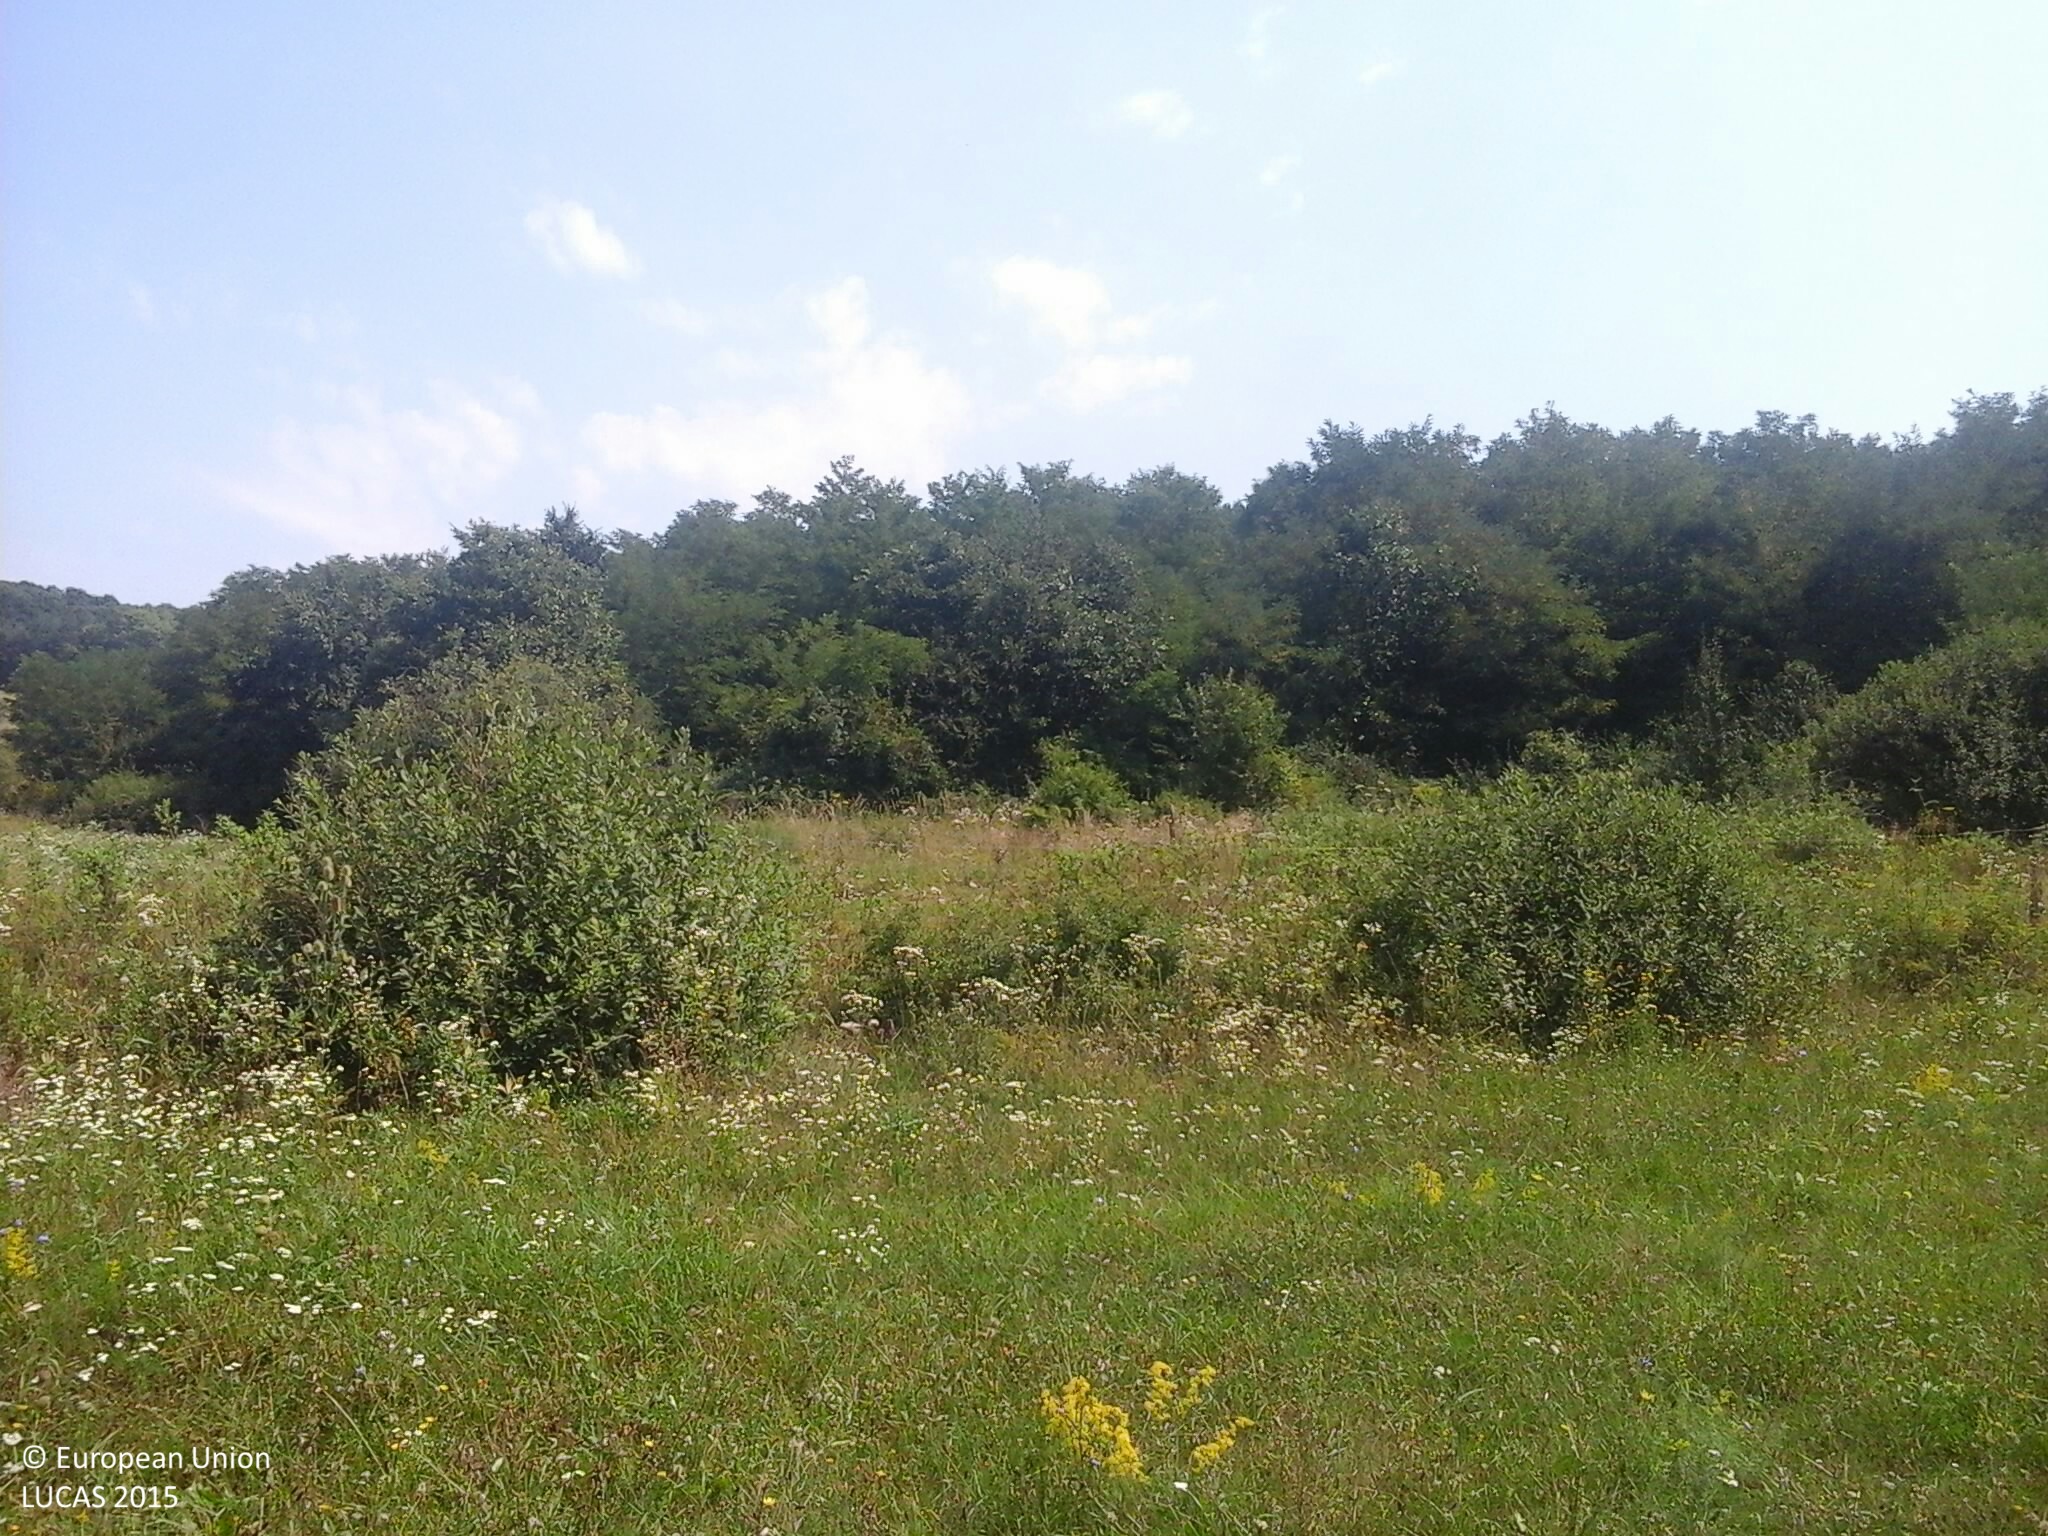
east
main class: Grassland
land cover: Grassland without tree/shrub cover
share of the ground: > 75 %
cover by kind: herbaceous plants 100 %
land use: Agriculture (excluding fallow land and kitchen gardens)
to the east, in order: Grassland without tree/shrub cover; Tracks; Grassland without tree/shrub cover; Tracks; Grassland without tree/shrub cover; Broadleaved woodland; Grassland without tree/shrub cover
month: August
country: HU
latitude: 48.4878
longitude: 20.8223
